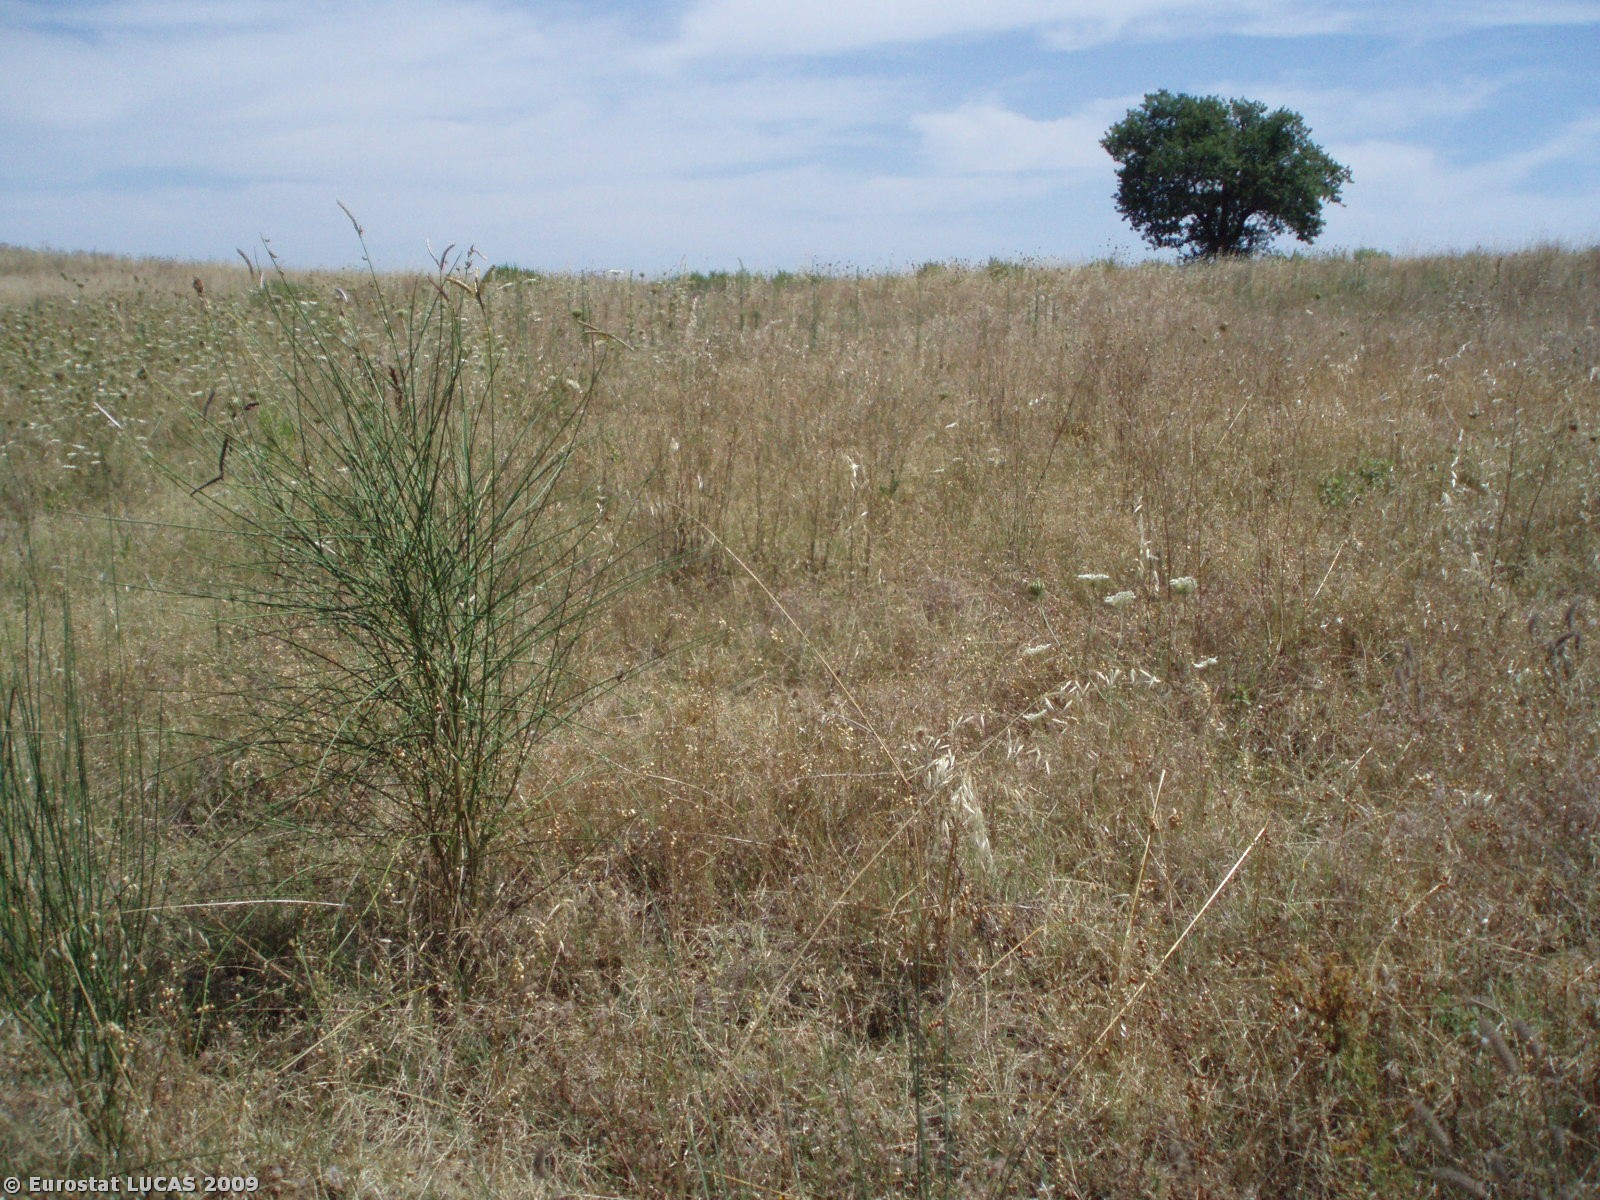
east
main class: Grassland
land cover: Grassland with sparse tree/shrub cover
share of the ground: > 75 %
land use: Fallow land
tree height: > 5 m
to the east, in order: Grassland with sparse tree/shrub cover
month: July
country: IT
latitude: 42.7191
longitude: 11.2049
